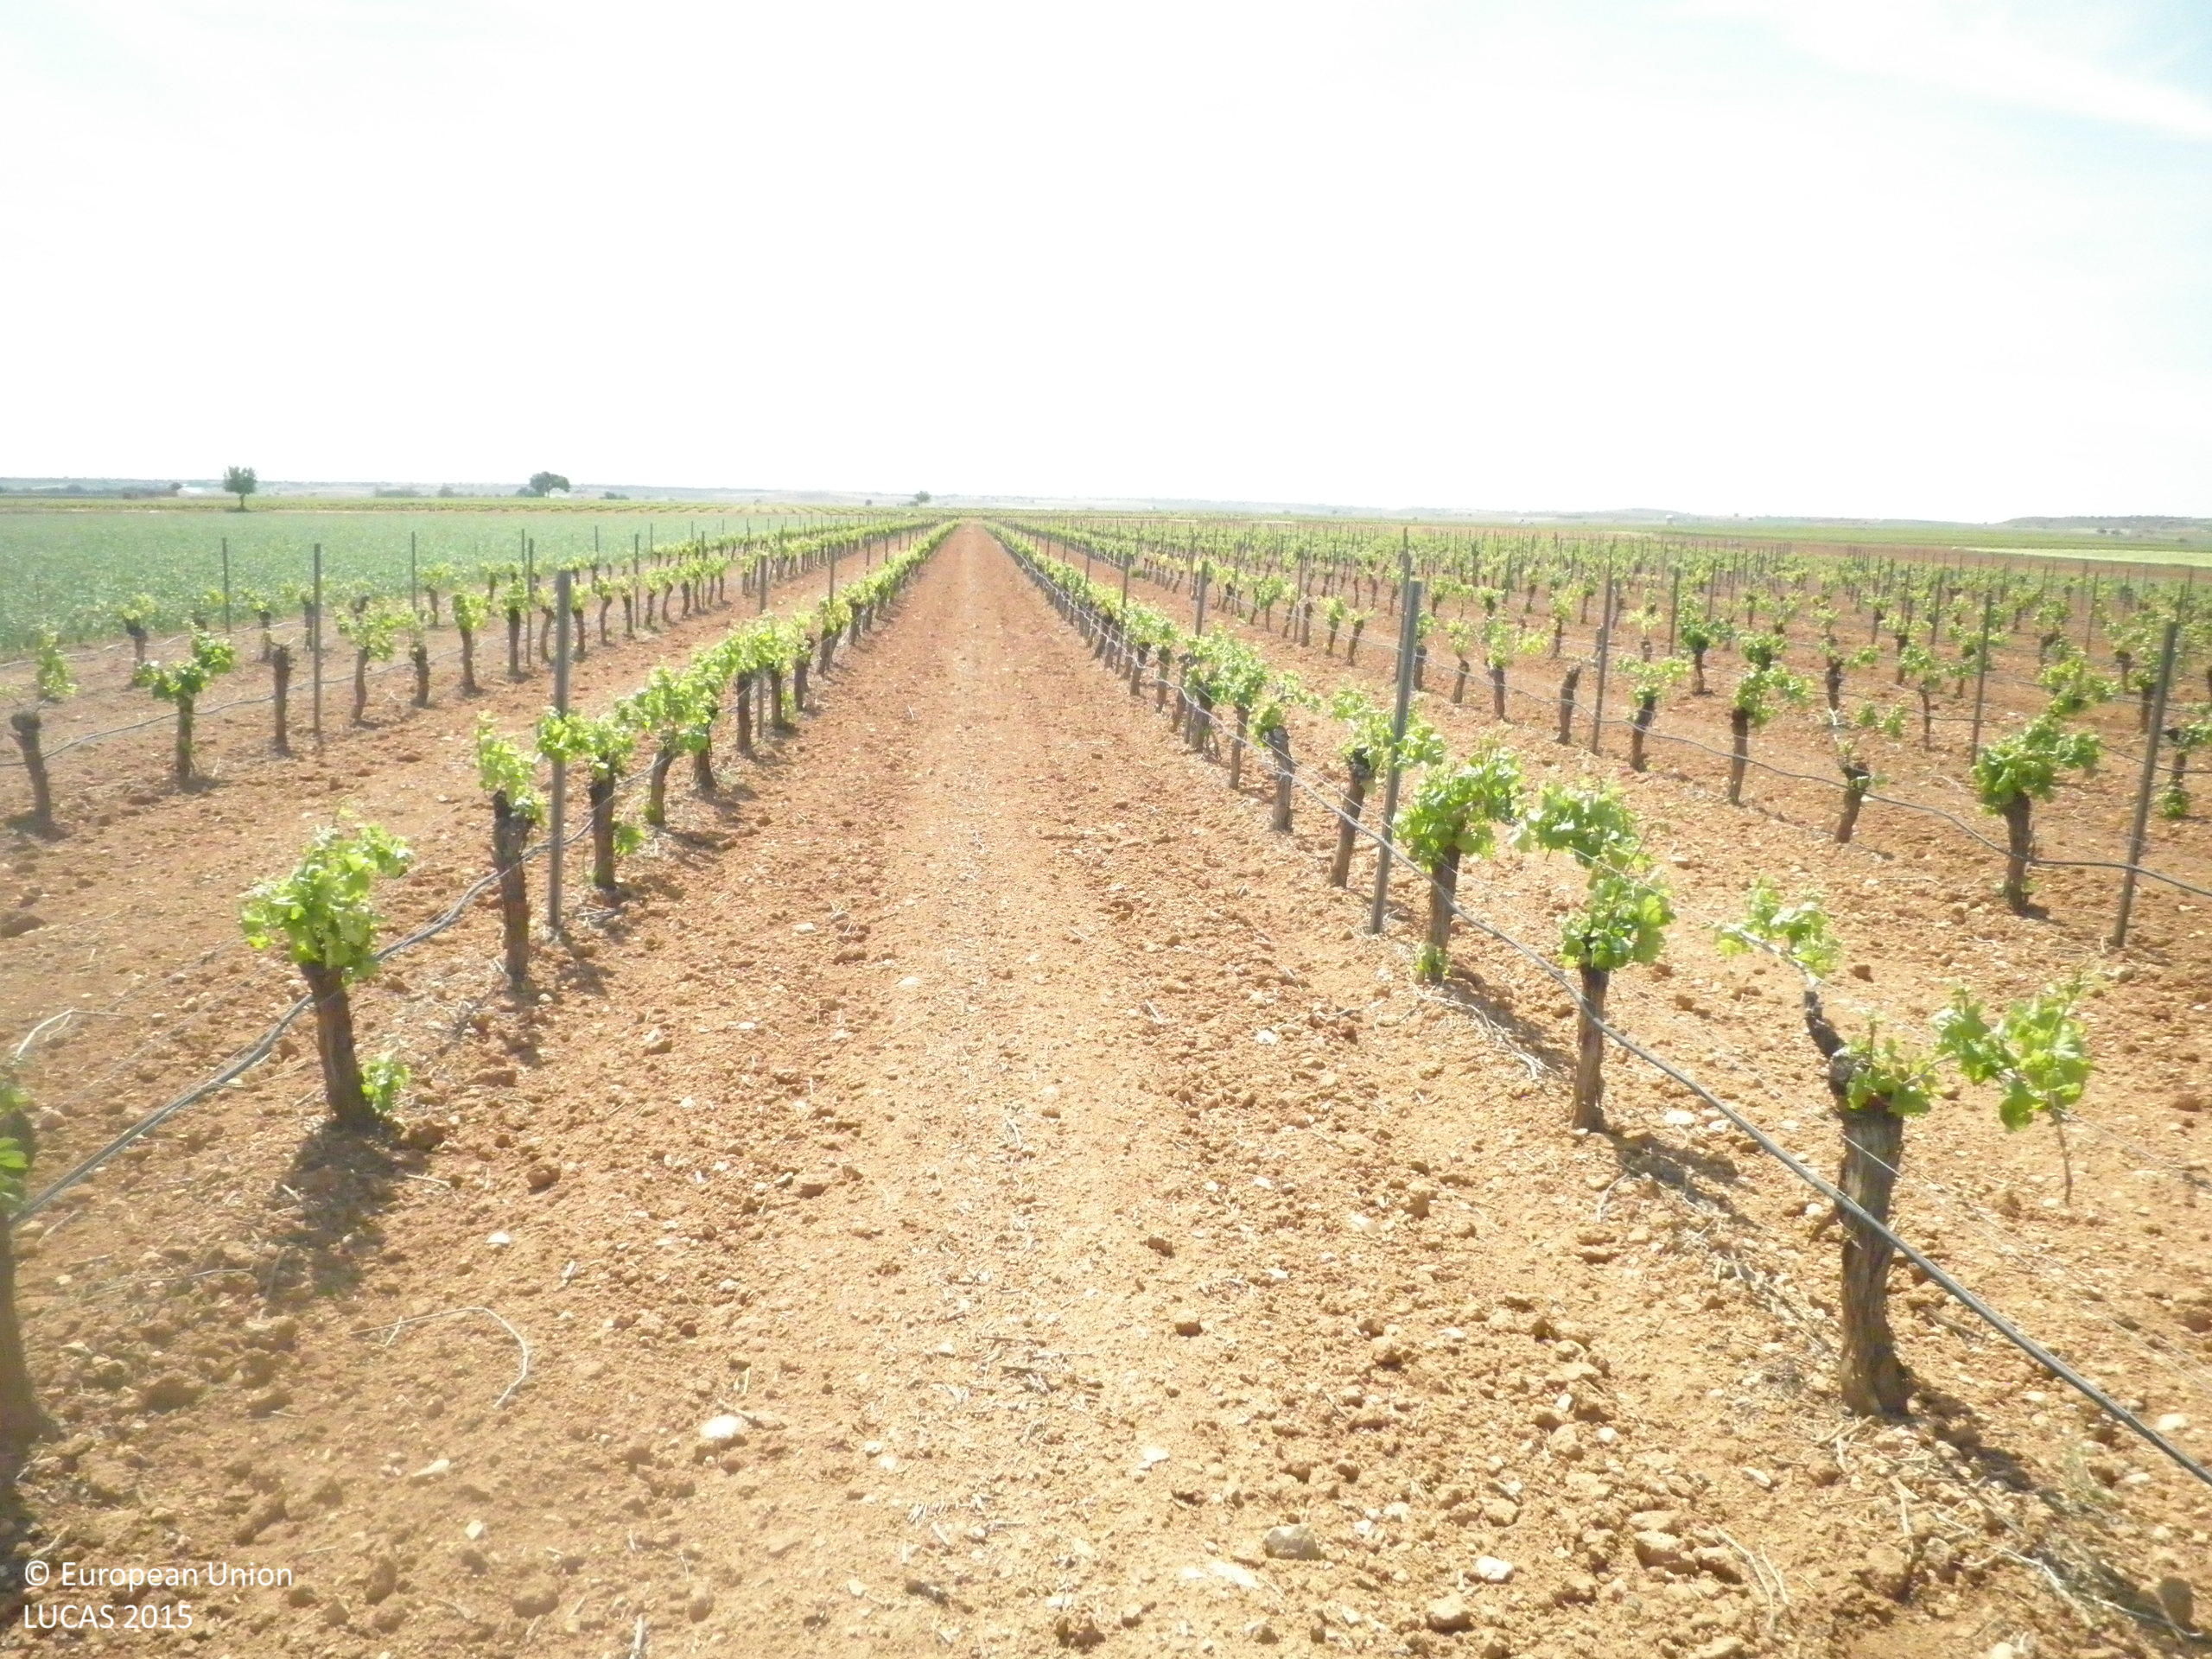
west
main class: Cropland
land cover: Vineyards
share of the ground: < 10 %
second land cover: Other bare soil
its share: > 75 %
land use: Agriculture (excluding fallow land and kitchen gardens)
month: May
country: ES
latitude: 39.5555
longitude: -2.7827
